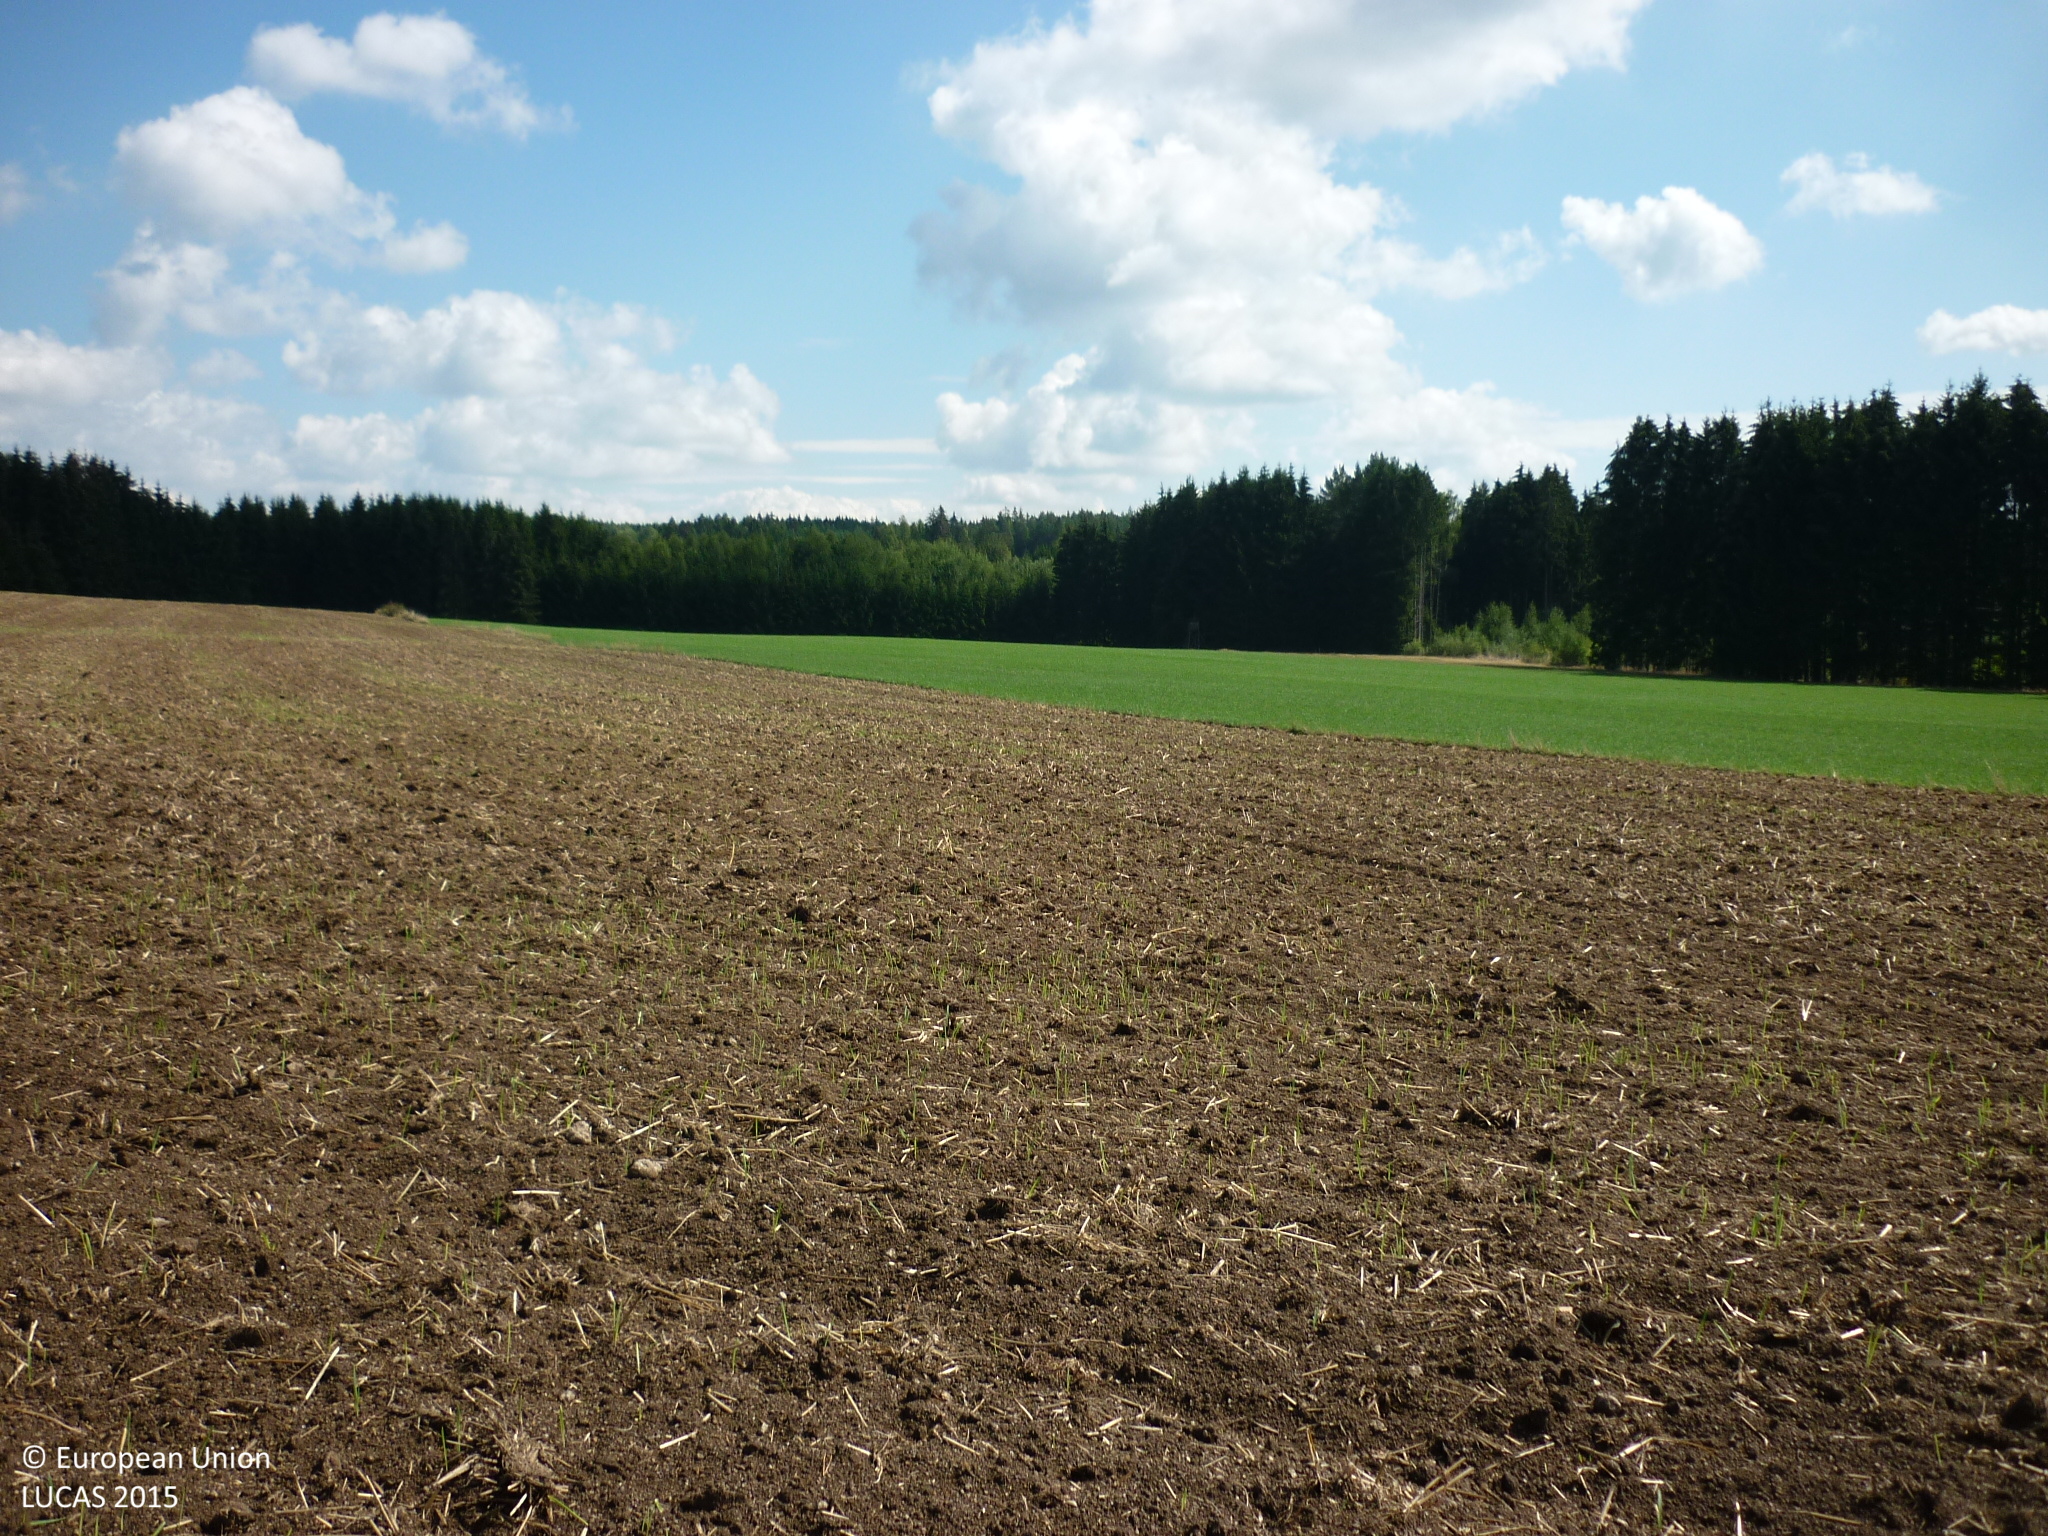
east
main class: Cropland
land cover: Rye
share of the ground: < 10 %
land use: Agriculture (excluding fallow land and kitchen gardens)
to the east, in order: Rye; Grassland without tree/shrub cover; Temporary grasslands
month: September
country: AT
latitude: 48.9710
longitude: 15.0978
